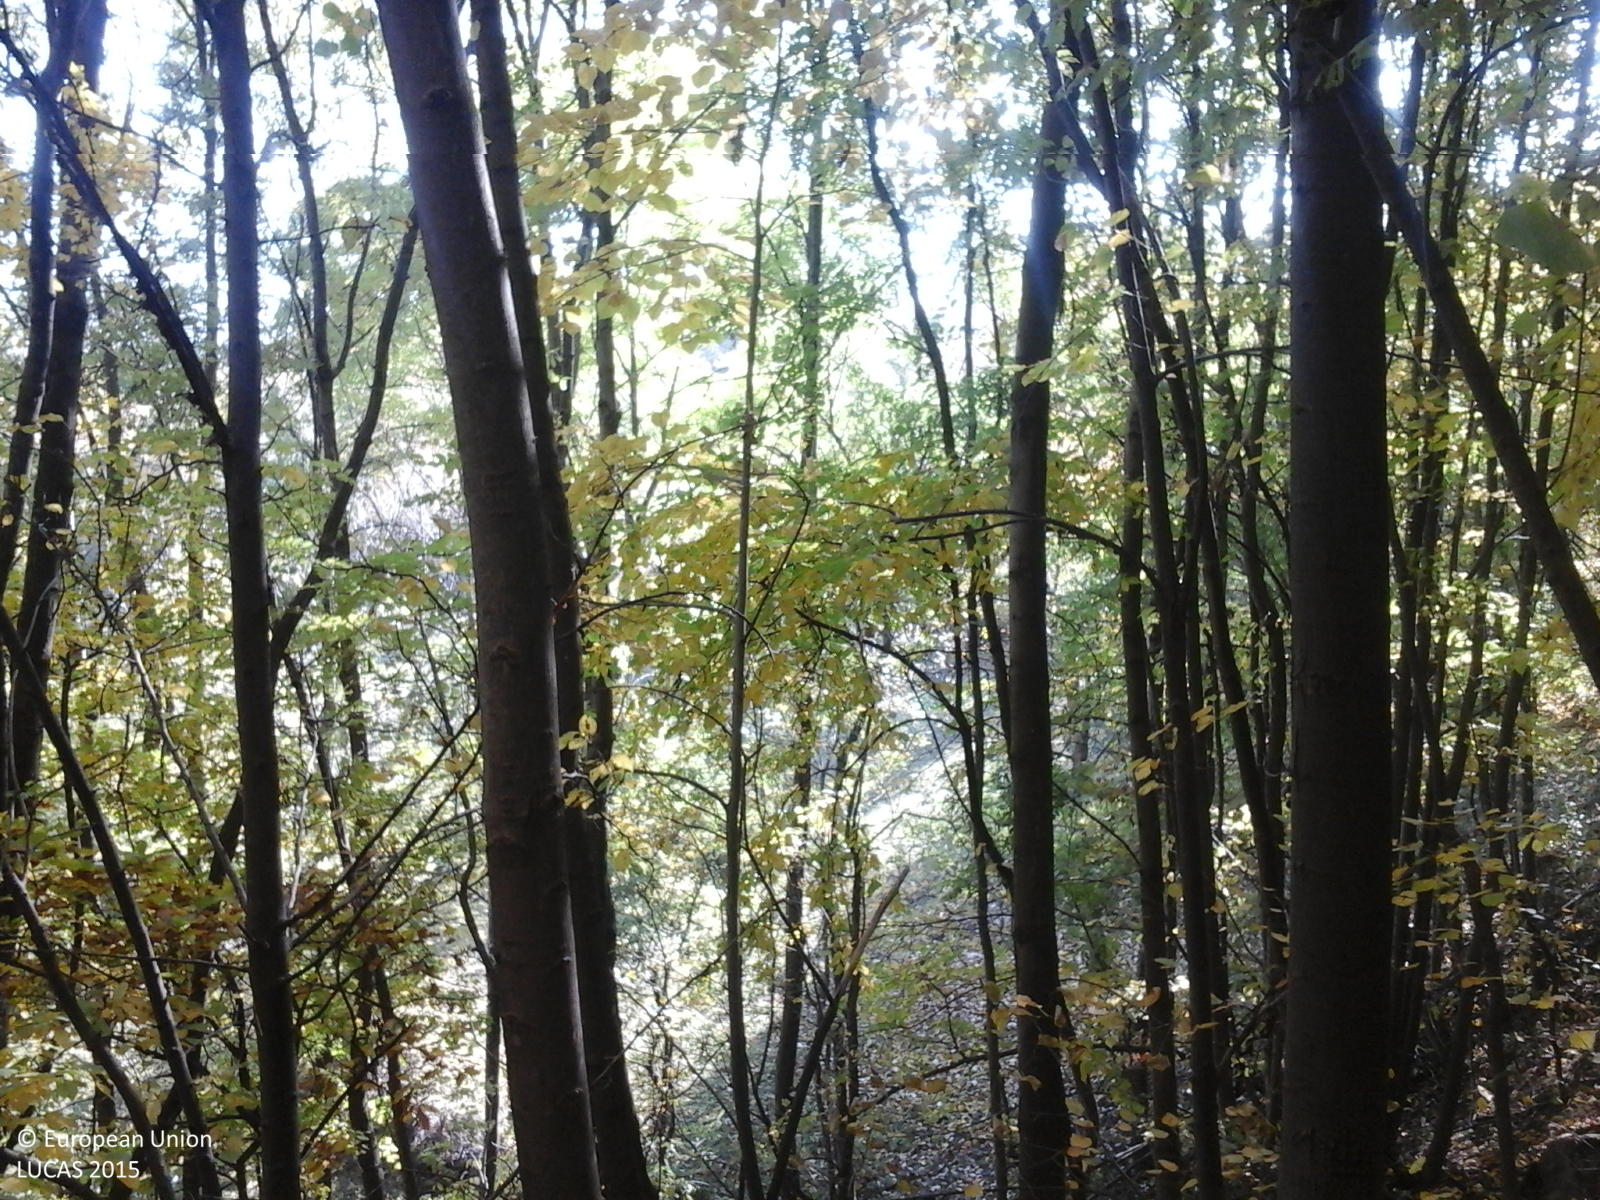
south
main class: Woodland
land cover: Broadleaved woodland
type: non-riverine alder, birch or aspen forest
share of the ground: > 75 %
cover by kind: broadleaved forest trees 100 %
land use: Forestry
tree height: > 5 m
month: October
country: RO
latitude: 45.4980
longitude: 26.6243
